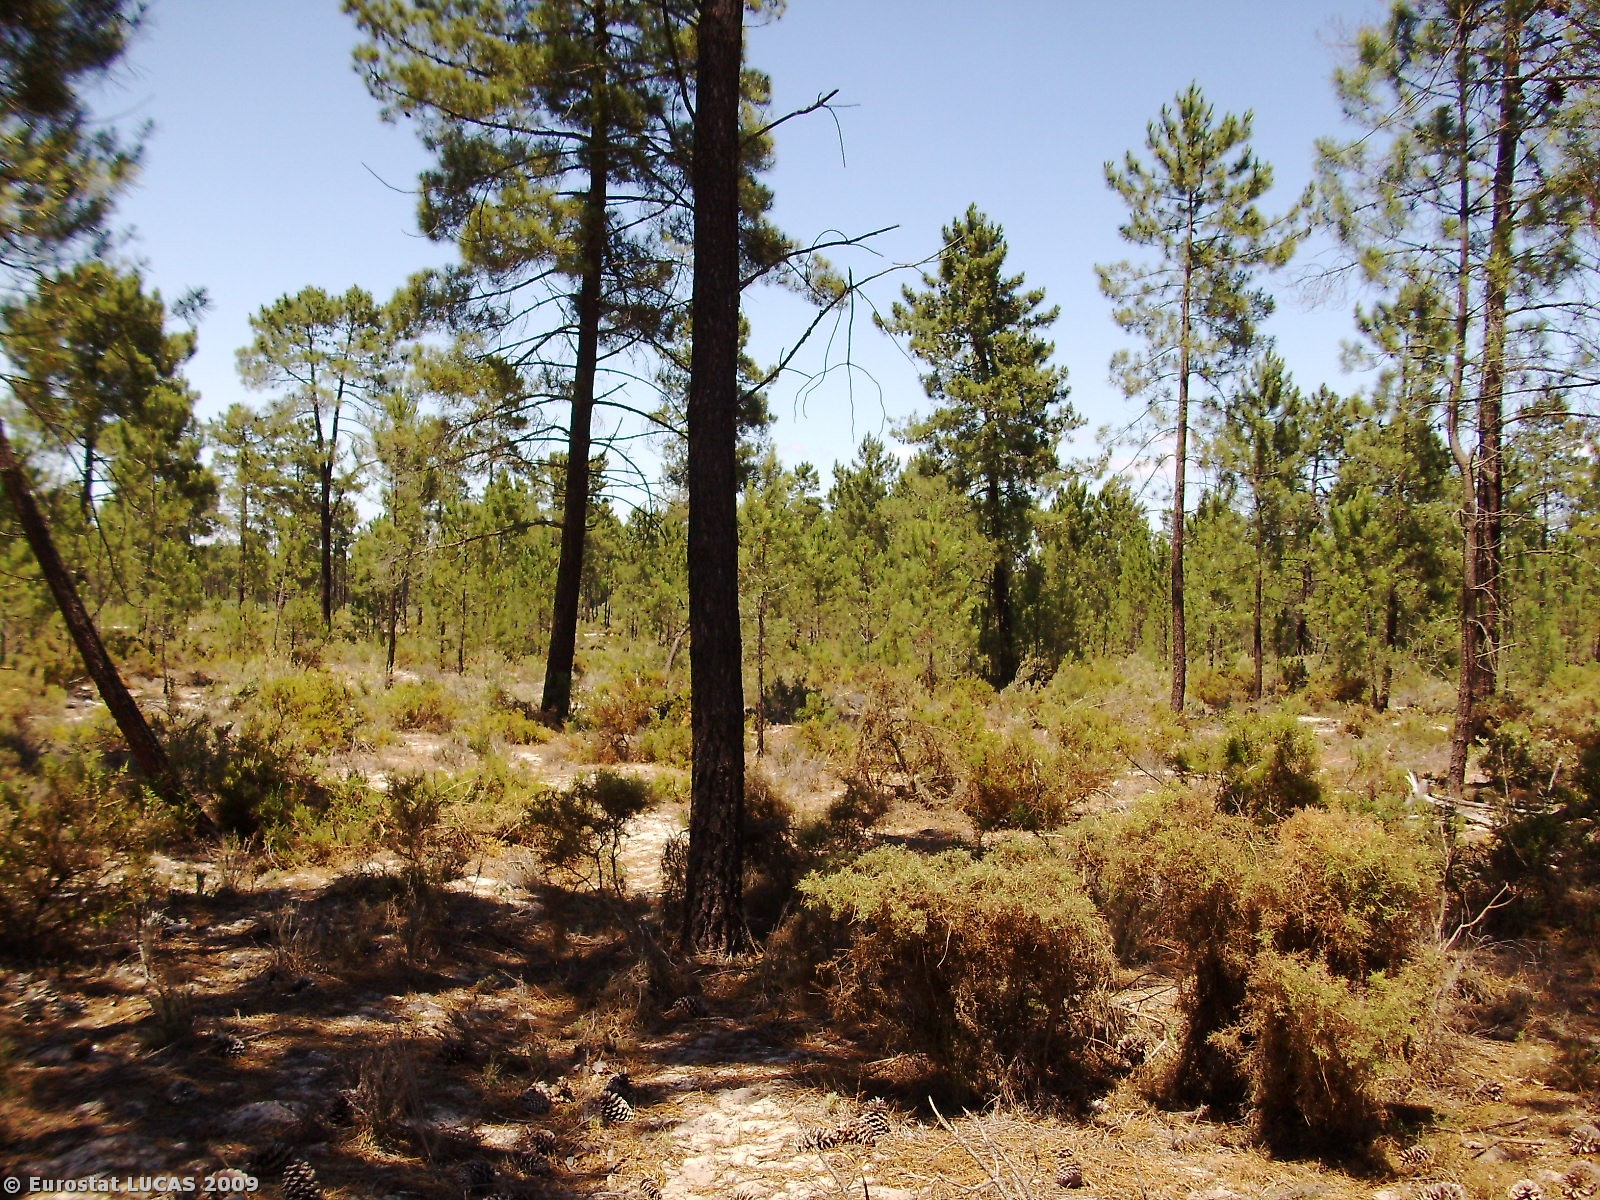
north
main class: Woodland
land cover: Coniferous woodland
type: coniferous forest of the mediterranean region
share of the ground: 50 - 75 %
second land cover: Shrubland with sparse tree cover
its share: 25 - 50 %
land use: Forestry
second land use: Agriculture (excluding fallow land and kitchen gardens)
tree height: > 5 m
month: June
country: PT
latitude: 38.2757
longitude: -8.6507
